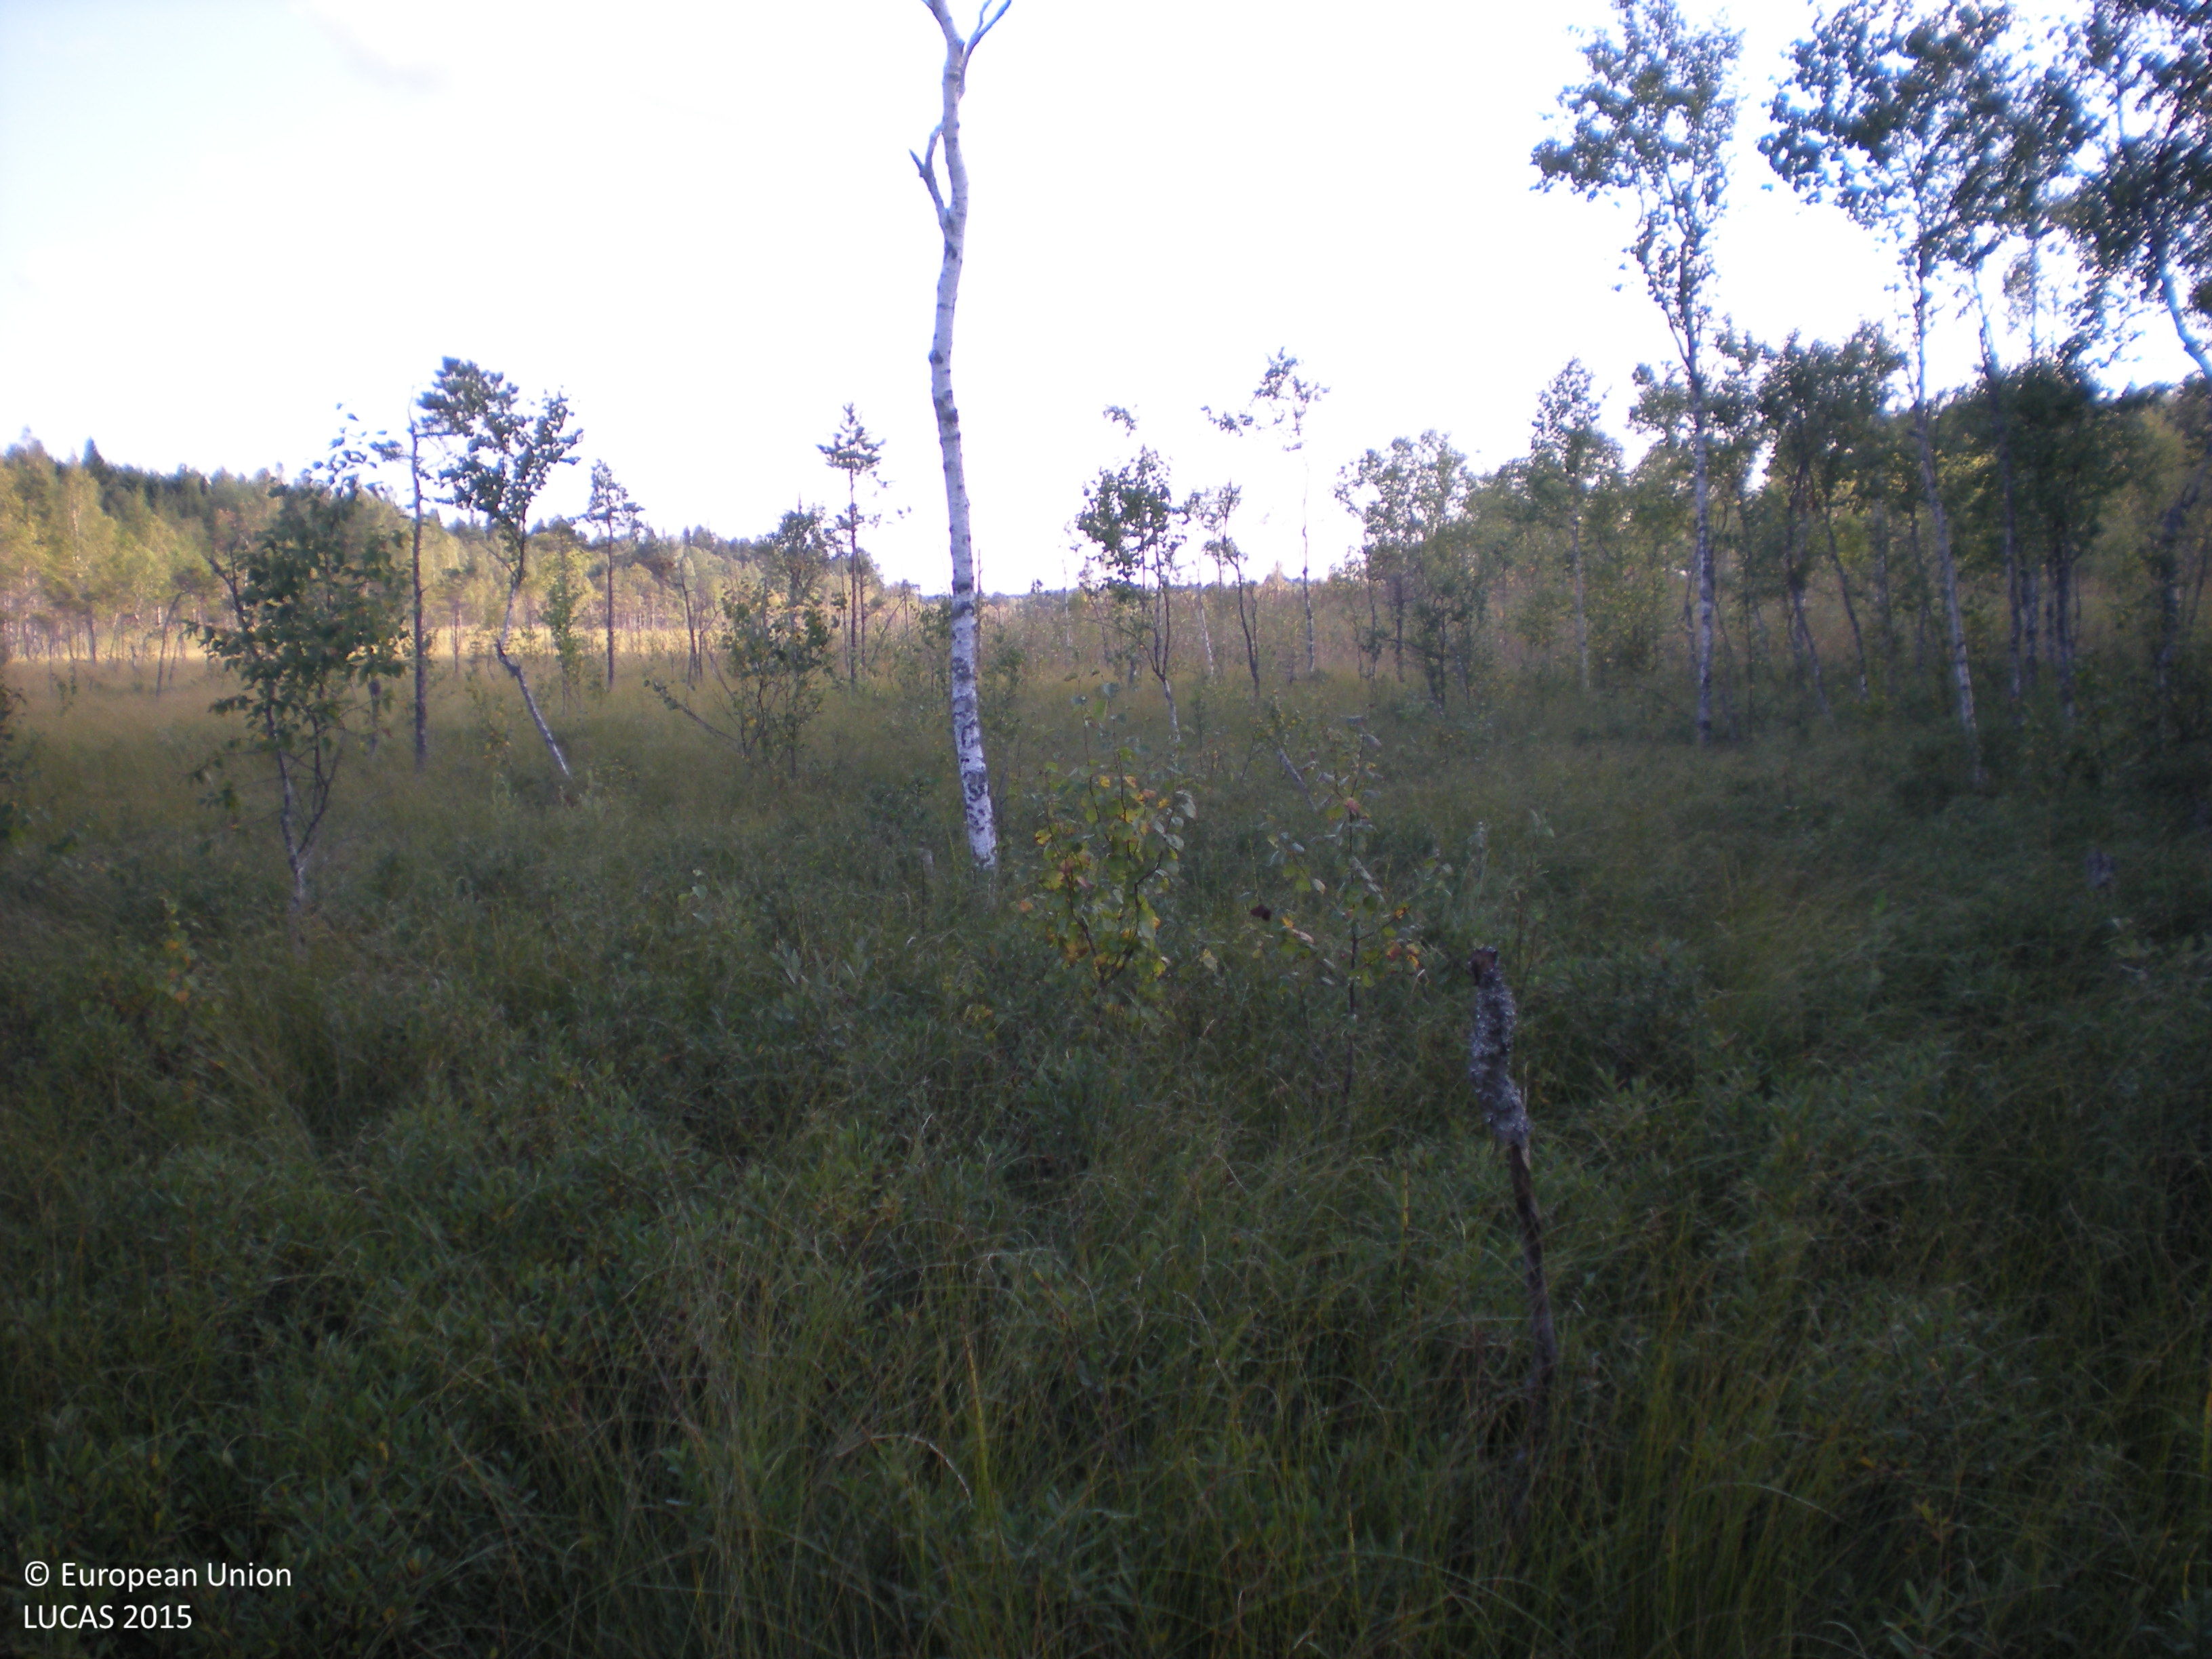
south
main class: Woodland
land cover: Broadleaved woodland
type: mire and swamp forests
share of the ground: > 75 %
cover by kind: herbaceous plants 70 %, broadleaved forest trees 15 %, shrubs 15 %
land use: Semi-natural and natural areas not in use
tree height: < 5 m
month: August
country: SE
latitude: 60.5453
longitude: 17.0813
